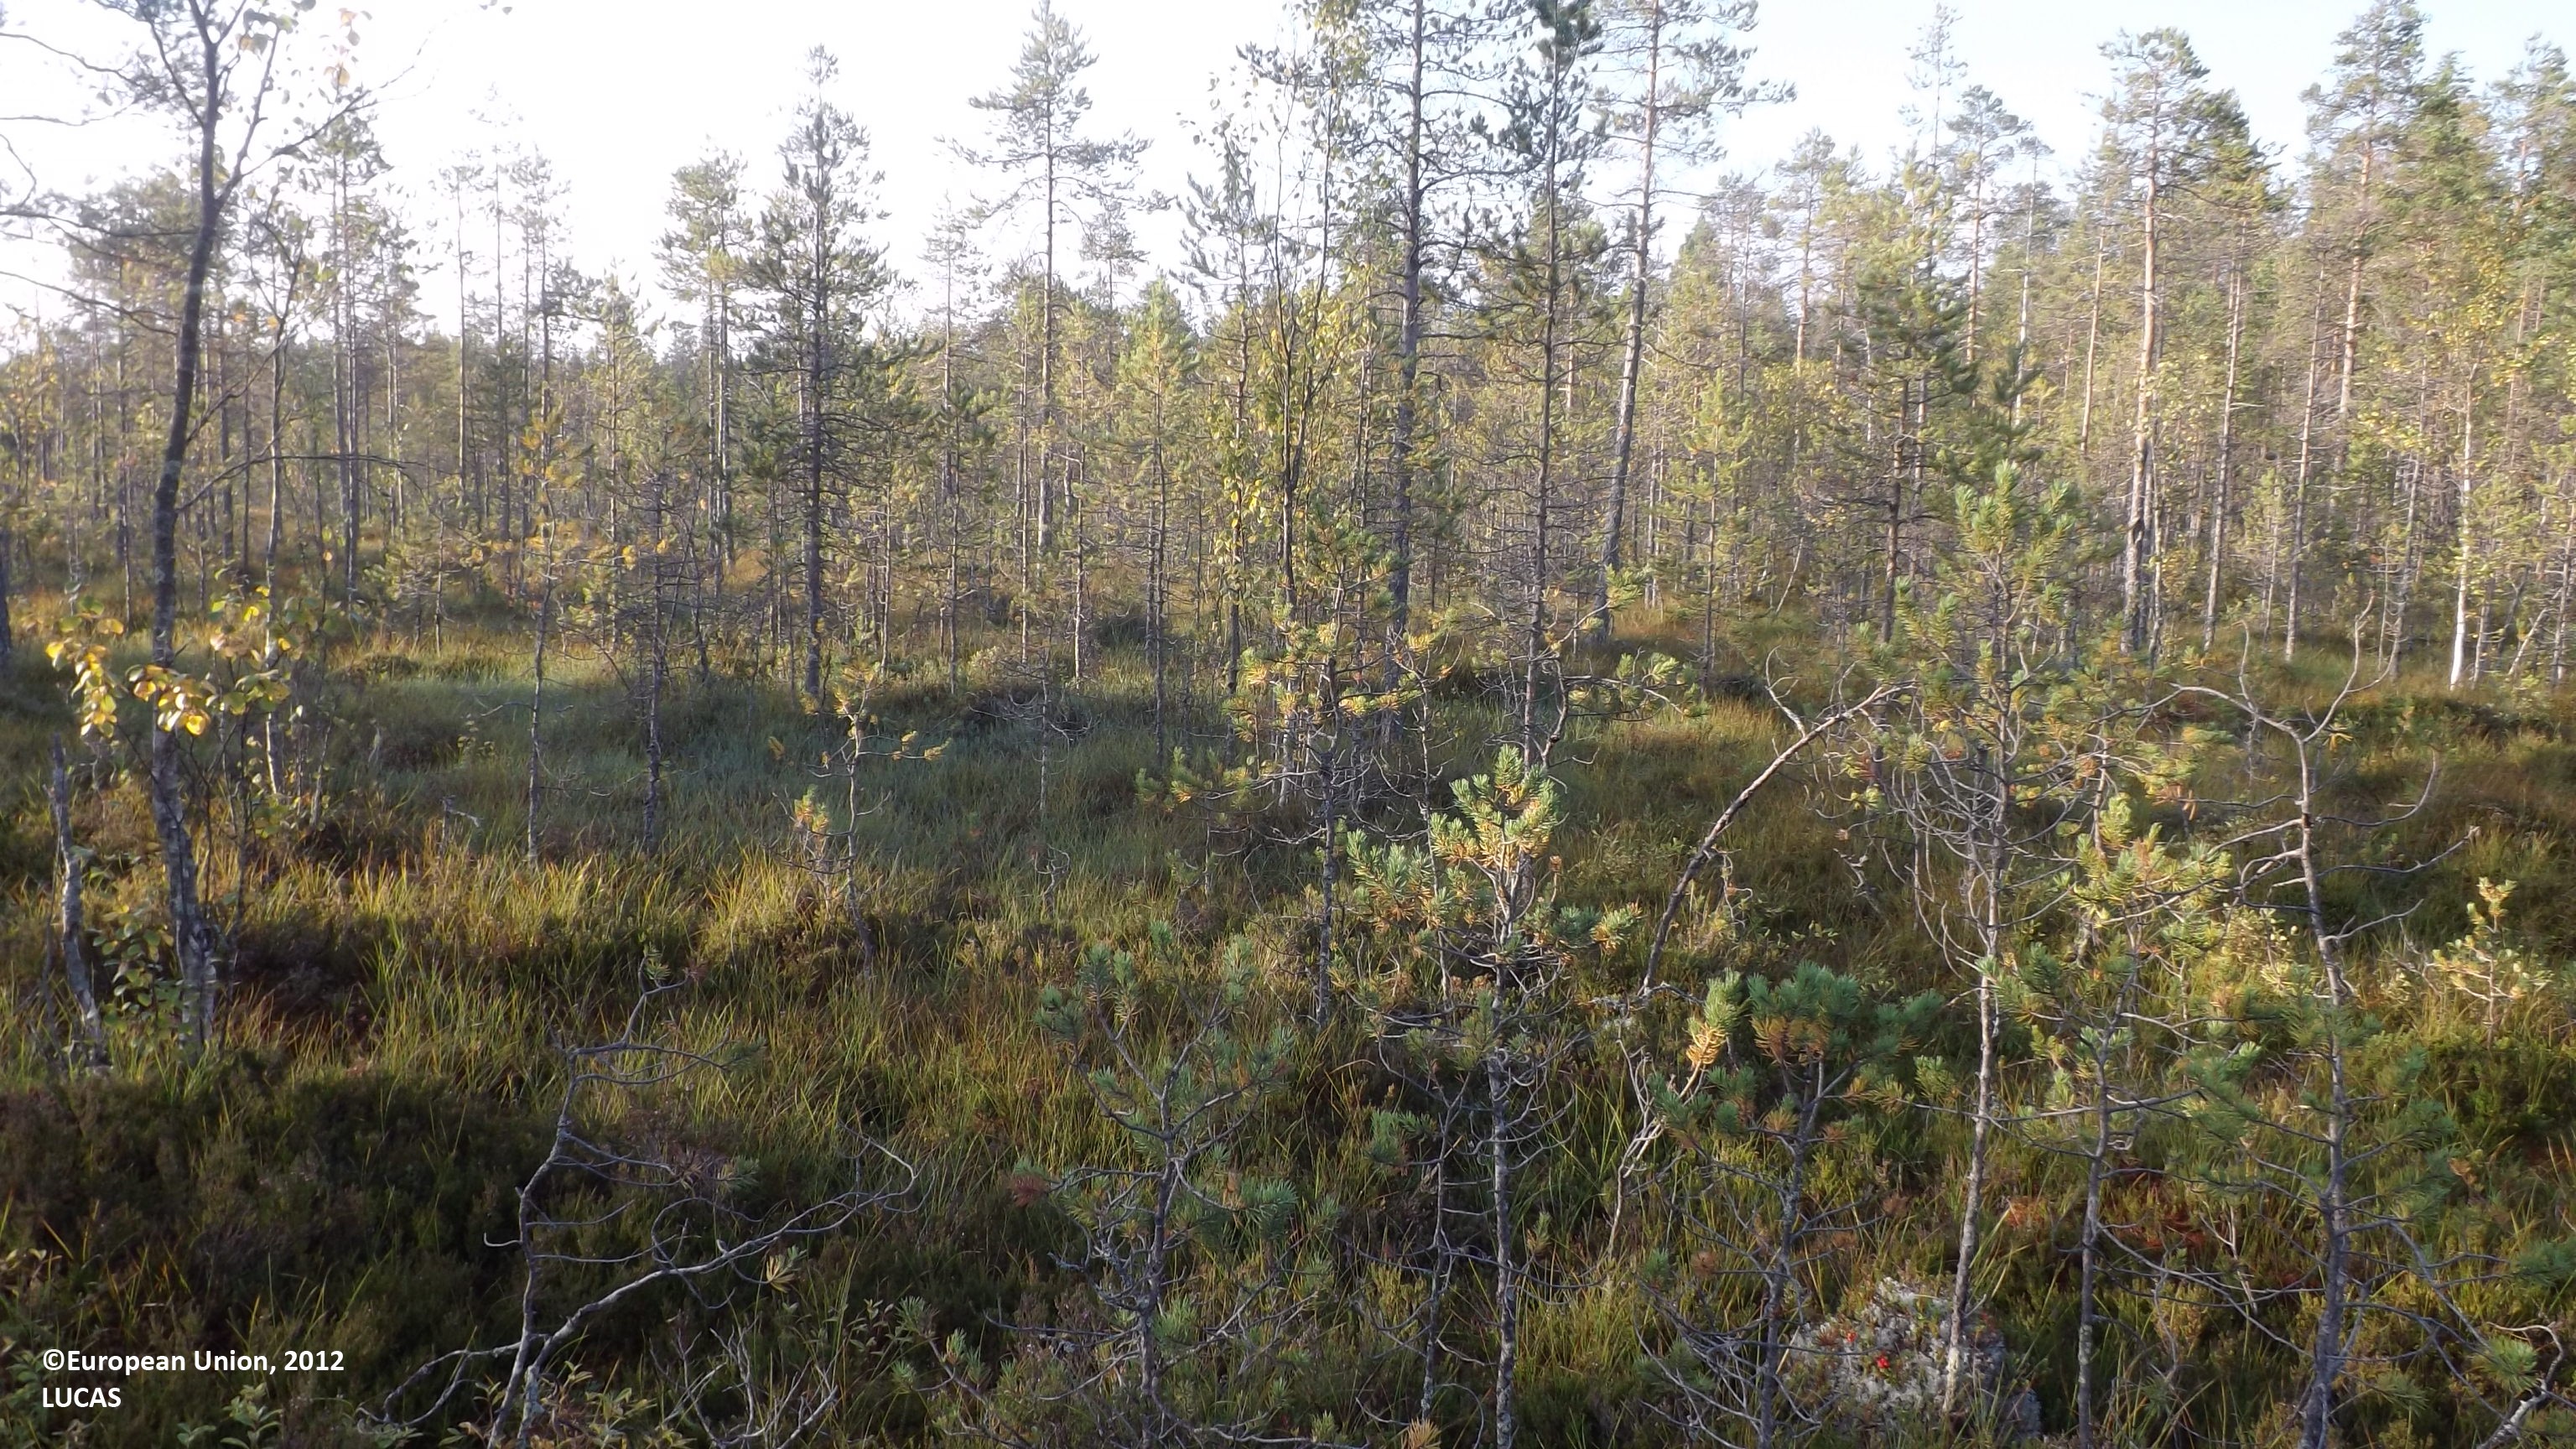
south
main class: Woodland
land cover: Pine dominated coniferous woodland
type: mire and swamp forests
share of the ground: 10 - 25 %
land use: Forestry
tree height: < 5 m
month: August
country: FI
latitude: 63.8015
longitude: 24.0979
